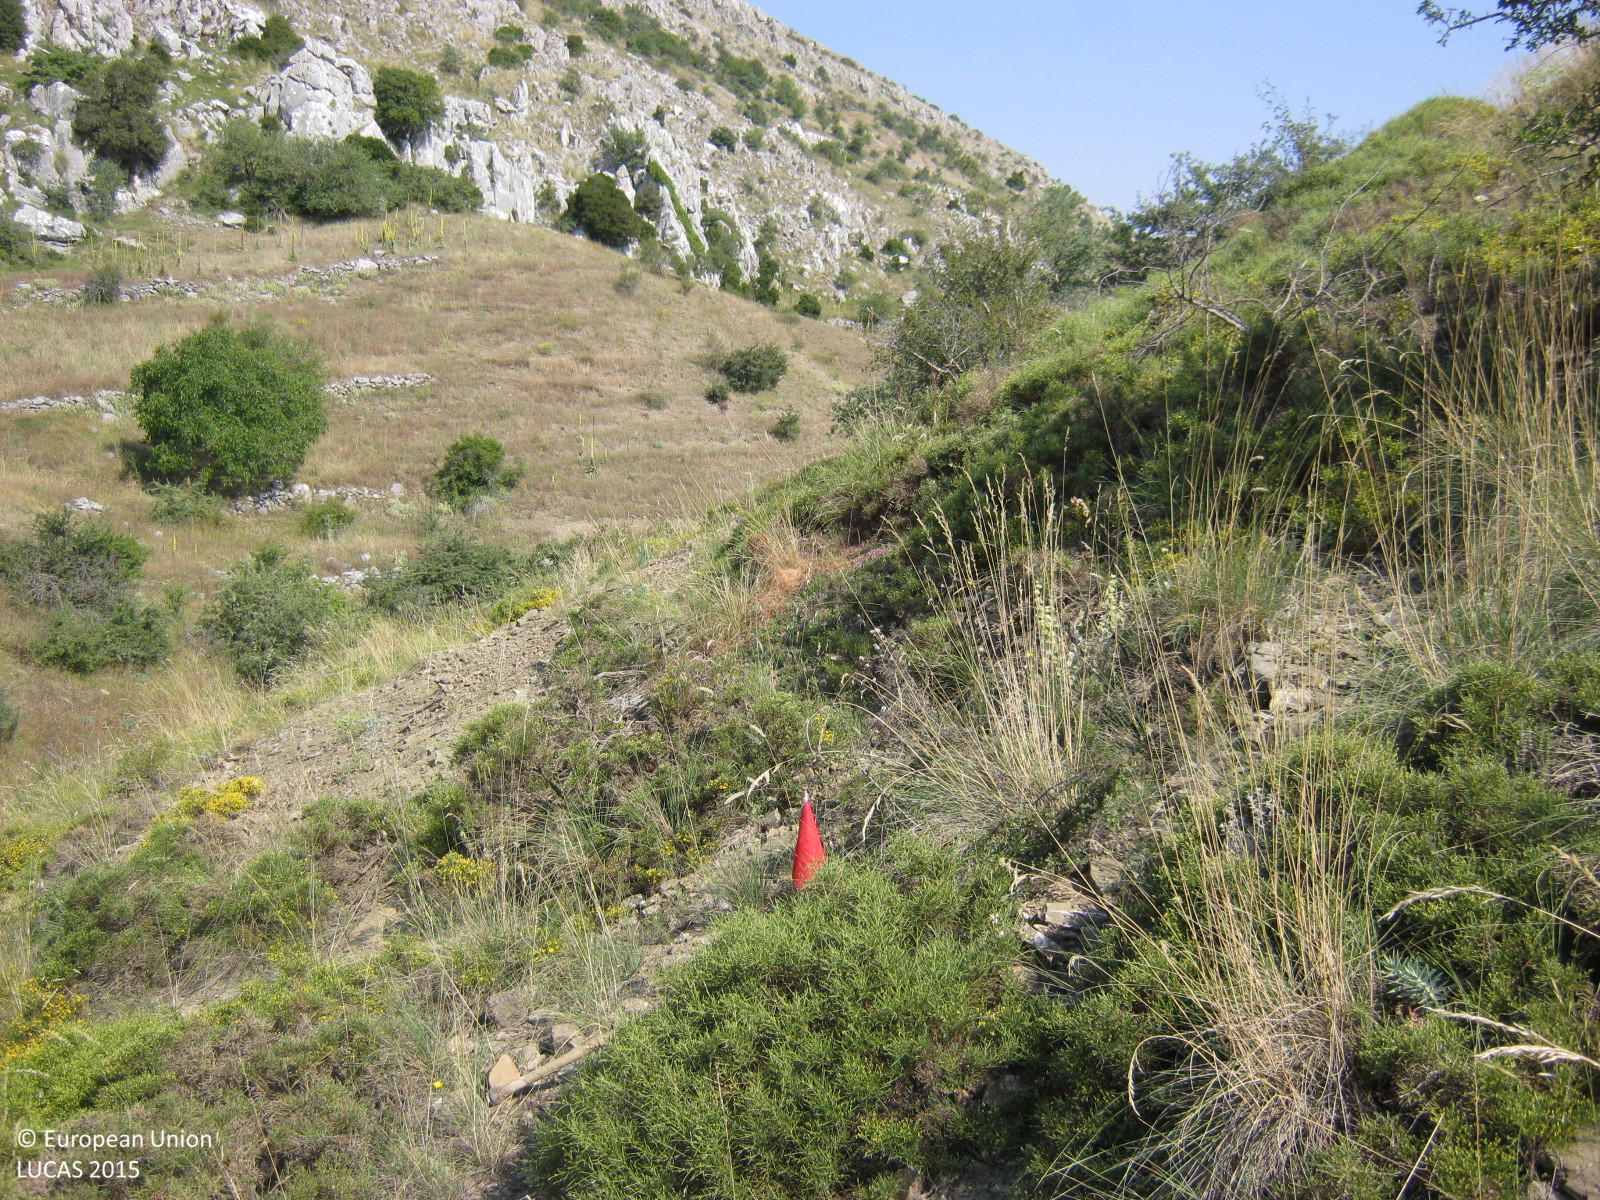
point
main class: Shrubland
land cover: Shrubland without tree cover
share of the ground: 50 - 75 %
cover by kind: shrubs 55 %, unconsolidated bare surface 25 %, herbaceous plants 20 %
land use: Semi-natural and natural areas not in use
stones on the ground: > 50 %
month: July
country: GR
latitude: 37.3616
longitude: 22.4819
